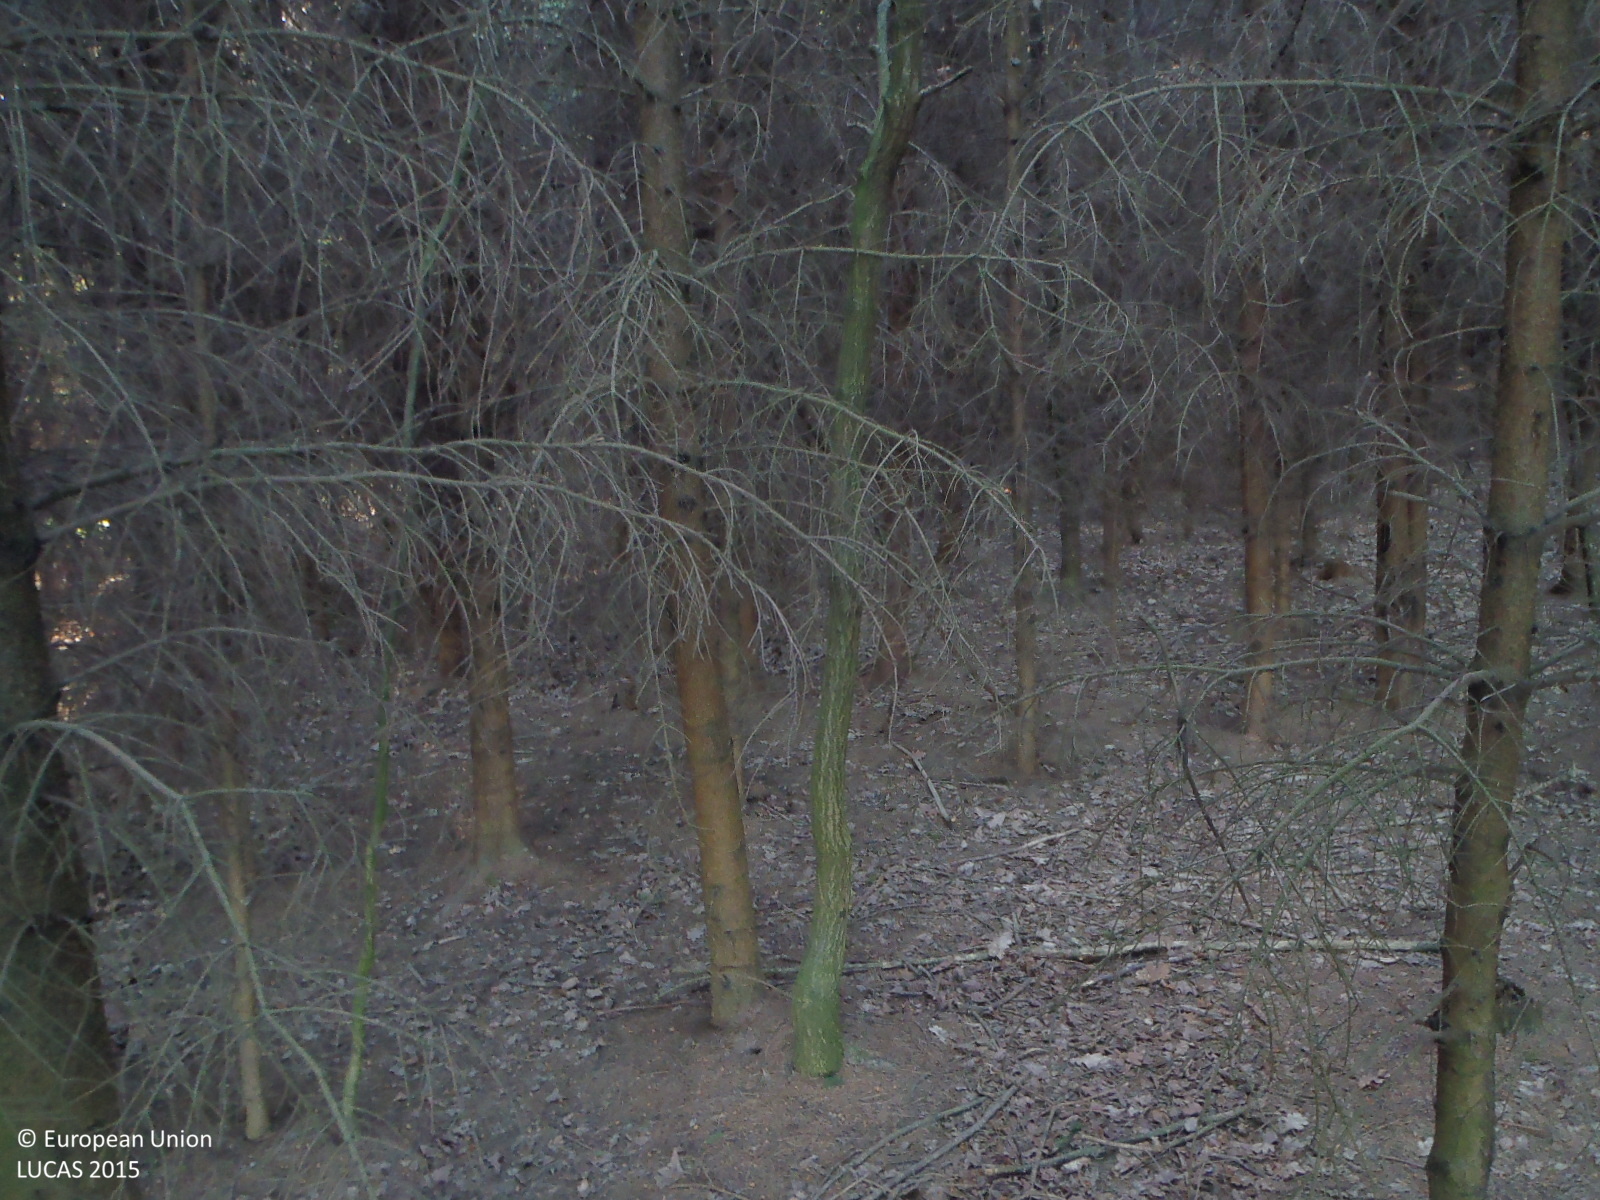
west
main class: Woodland
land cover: Spruce dominated coniferous woodland
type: hemiboreal forest and nemoral coniferous forest and mixed broadleaved-coniferous forest
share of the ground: > 75 %
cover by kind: coniferous forest trees 100 %
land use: Forestry
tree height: > 5 m
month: May
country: CZ
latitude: 49.0977
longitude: 15.4679
